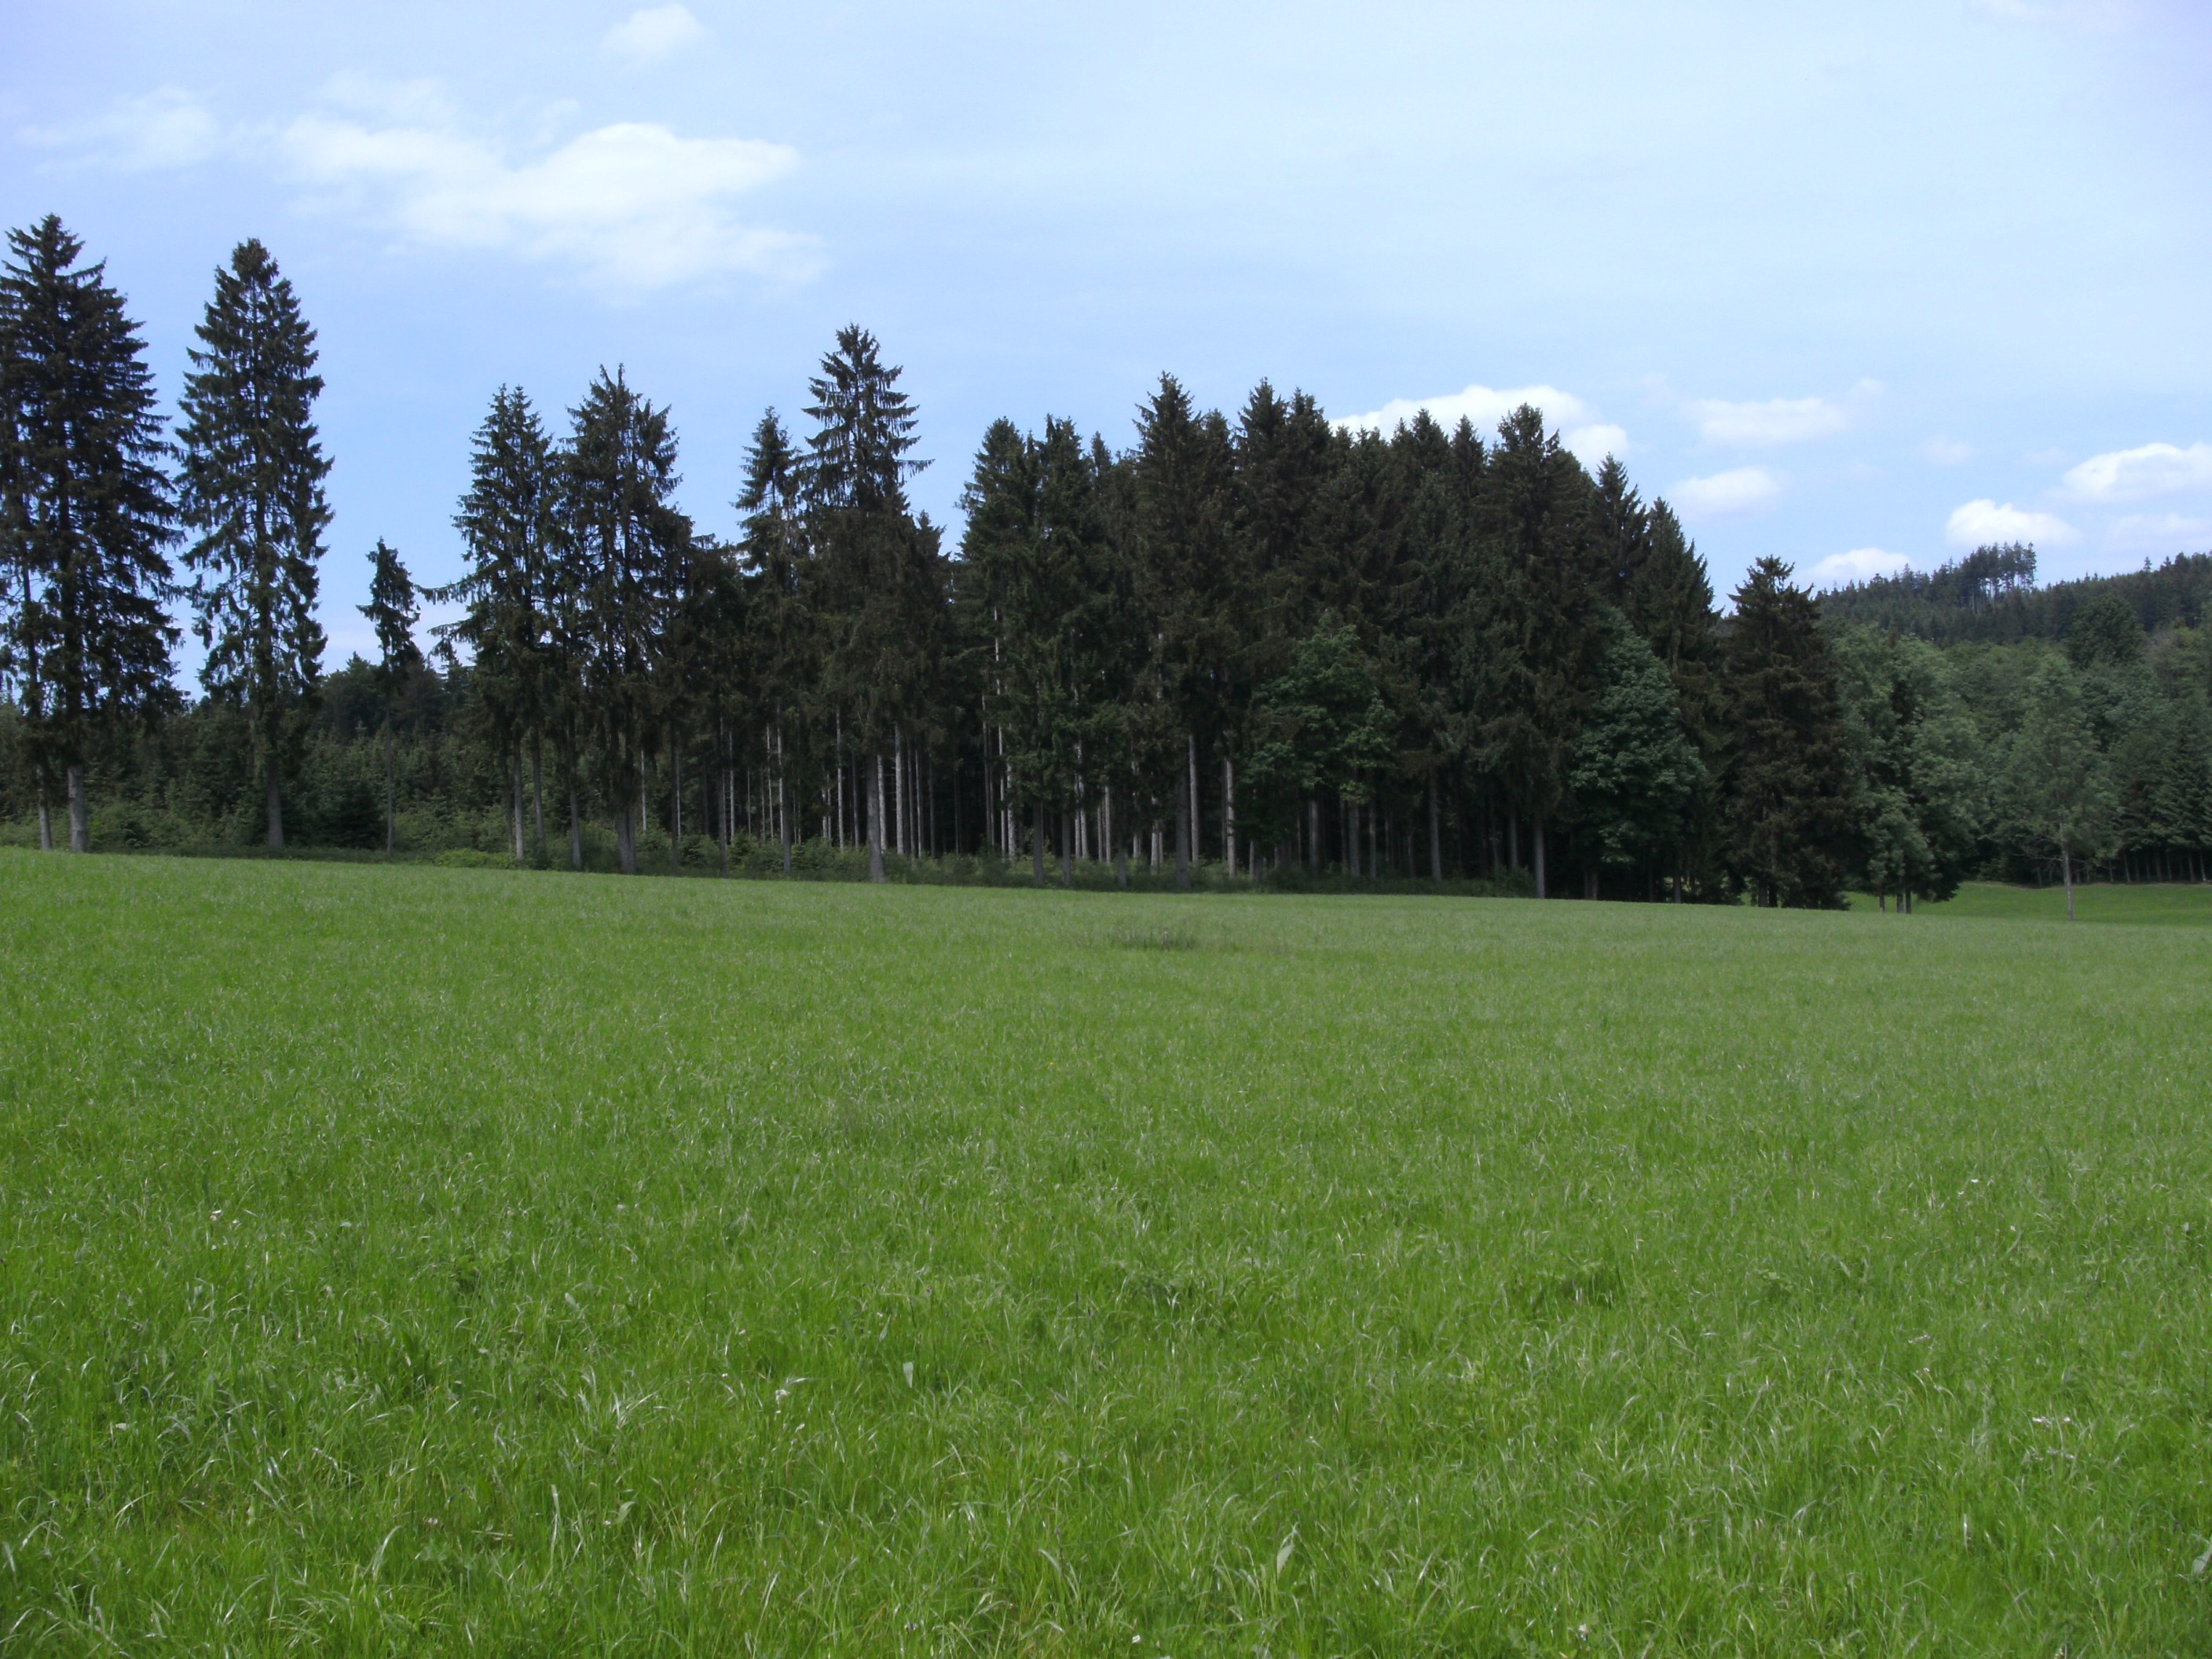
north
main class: Grassland
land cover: Grassland without tree/shrub cover
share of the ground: > 75 %
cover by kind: herbaceous plants 100 %
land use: Agriculture (excluding fallow land and kitchen gardens)
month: June
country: AT
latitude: 48.0967
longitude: 13.4769
